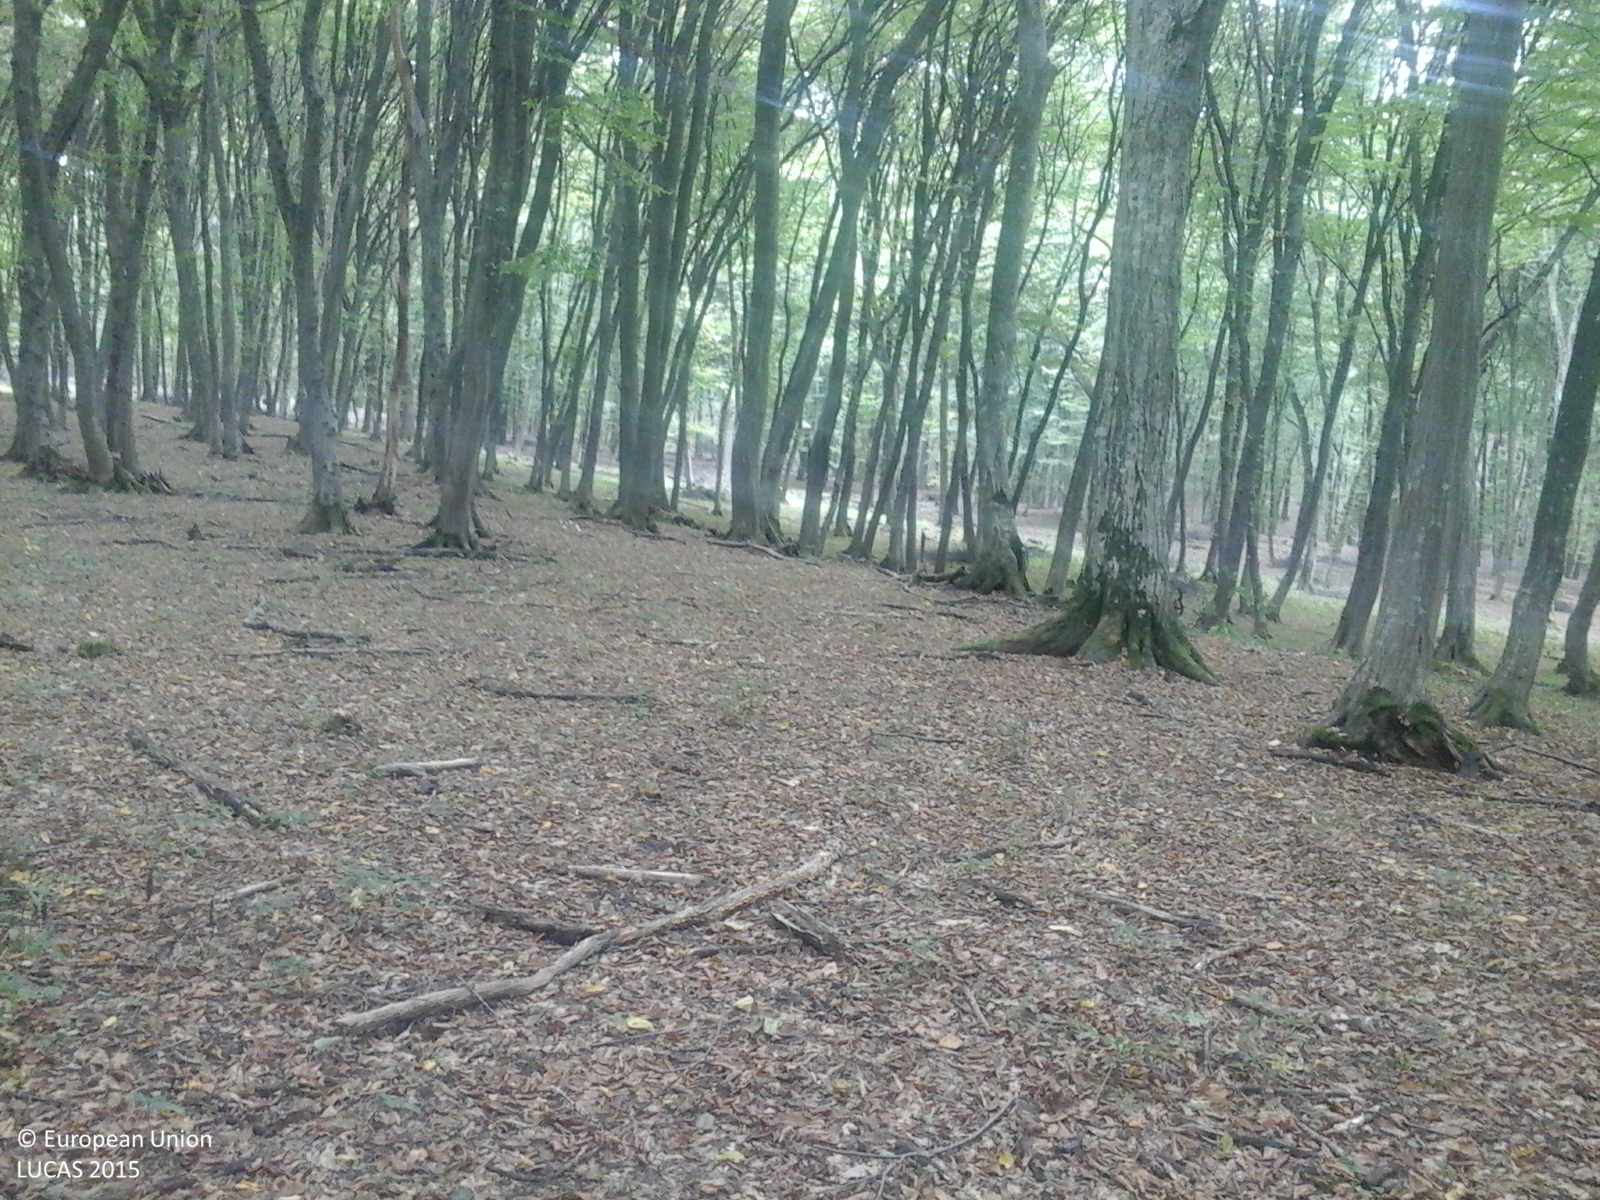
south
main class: Woodland
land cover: Broadleaved woodland
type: mesophytic deciduous forest
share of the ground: > 75 %
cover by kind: broadleaved forest trees 100 %
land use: Forestry
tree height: > 5 m
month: October
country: RO
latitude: 46.2568
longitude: 24.7360
